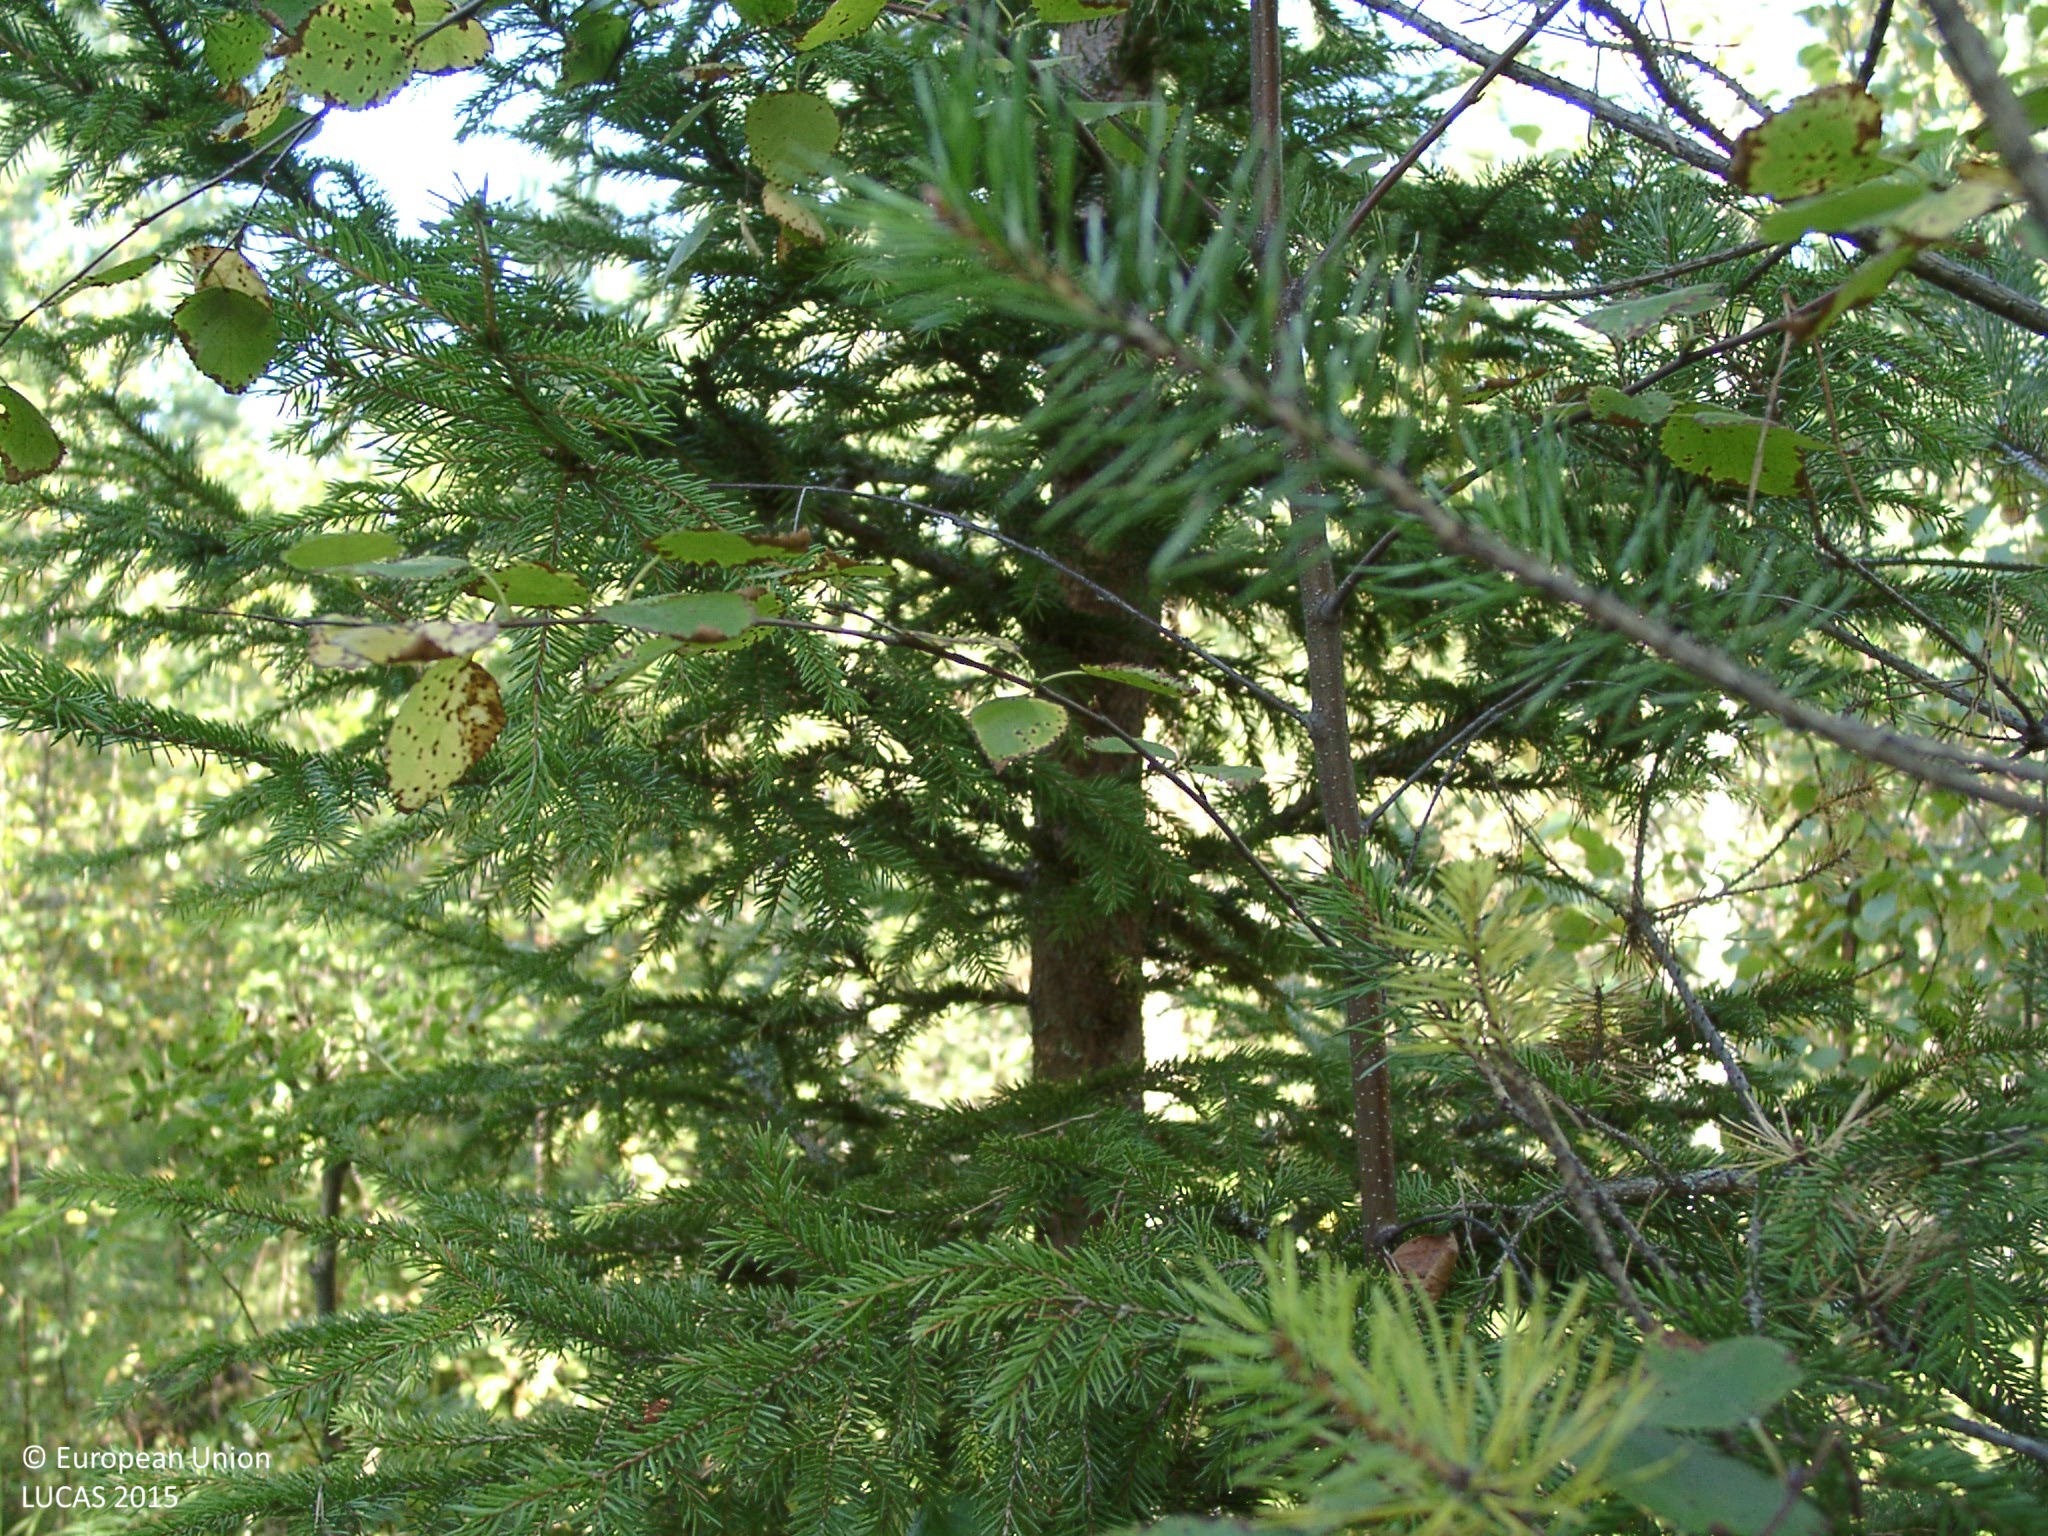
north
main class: Woodland
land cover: Pine dominated mixed woodland
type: boreal forest
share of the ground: 50 - 75 %
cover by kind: coniferous forest trees 50 %, broadleaved forest trees 20 %, shrubs 15 %, herbaceous plants 10 %, lichens and mosses 5 %
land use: Forestry
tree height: < 5 m
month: August
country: FI
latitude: 62.0053
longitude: 24.7859
